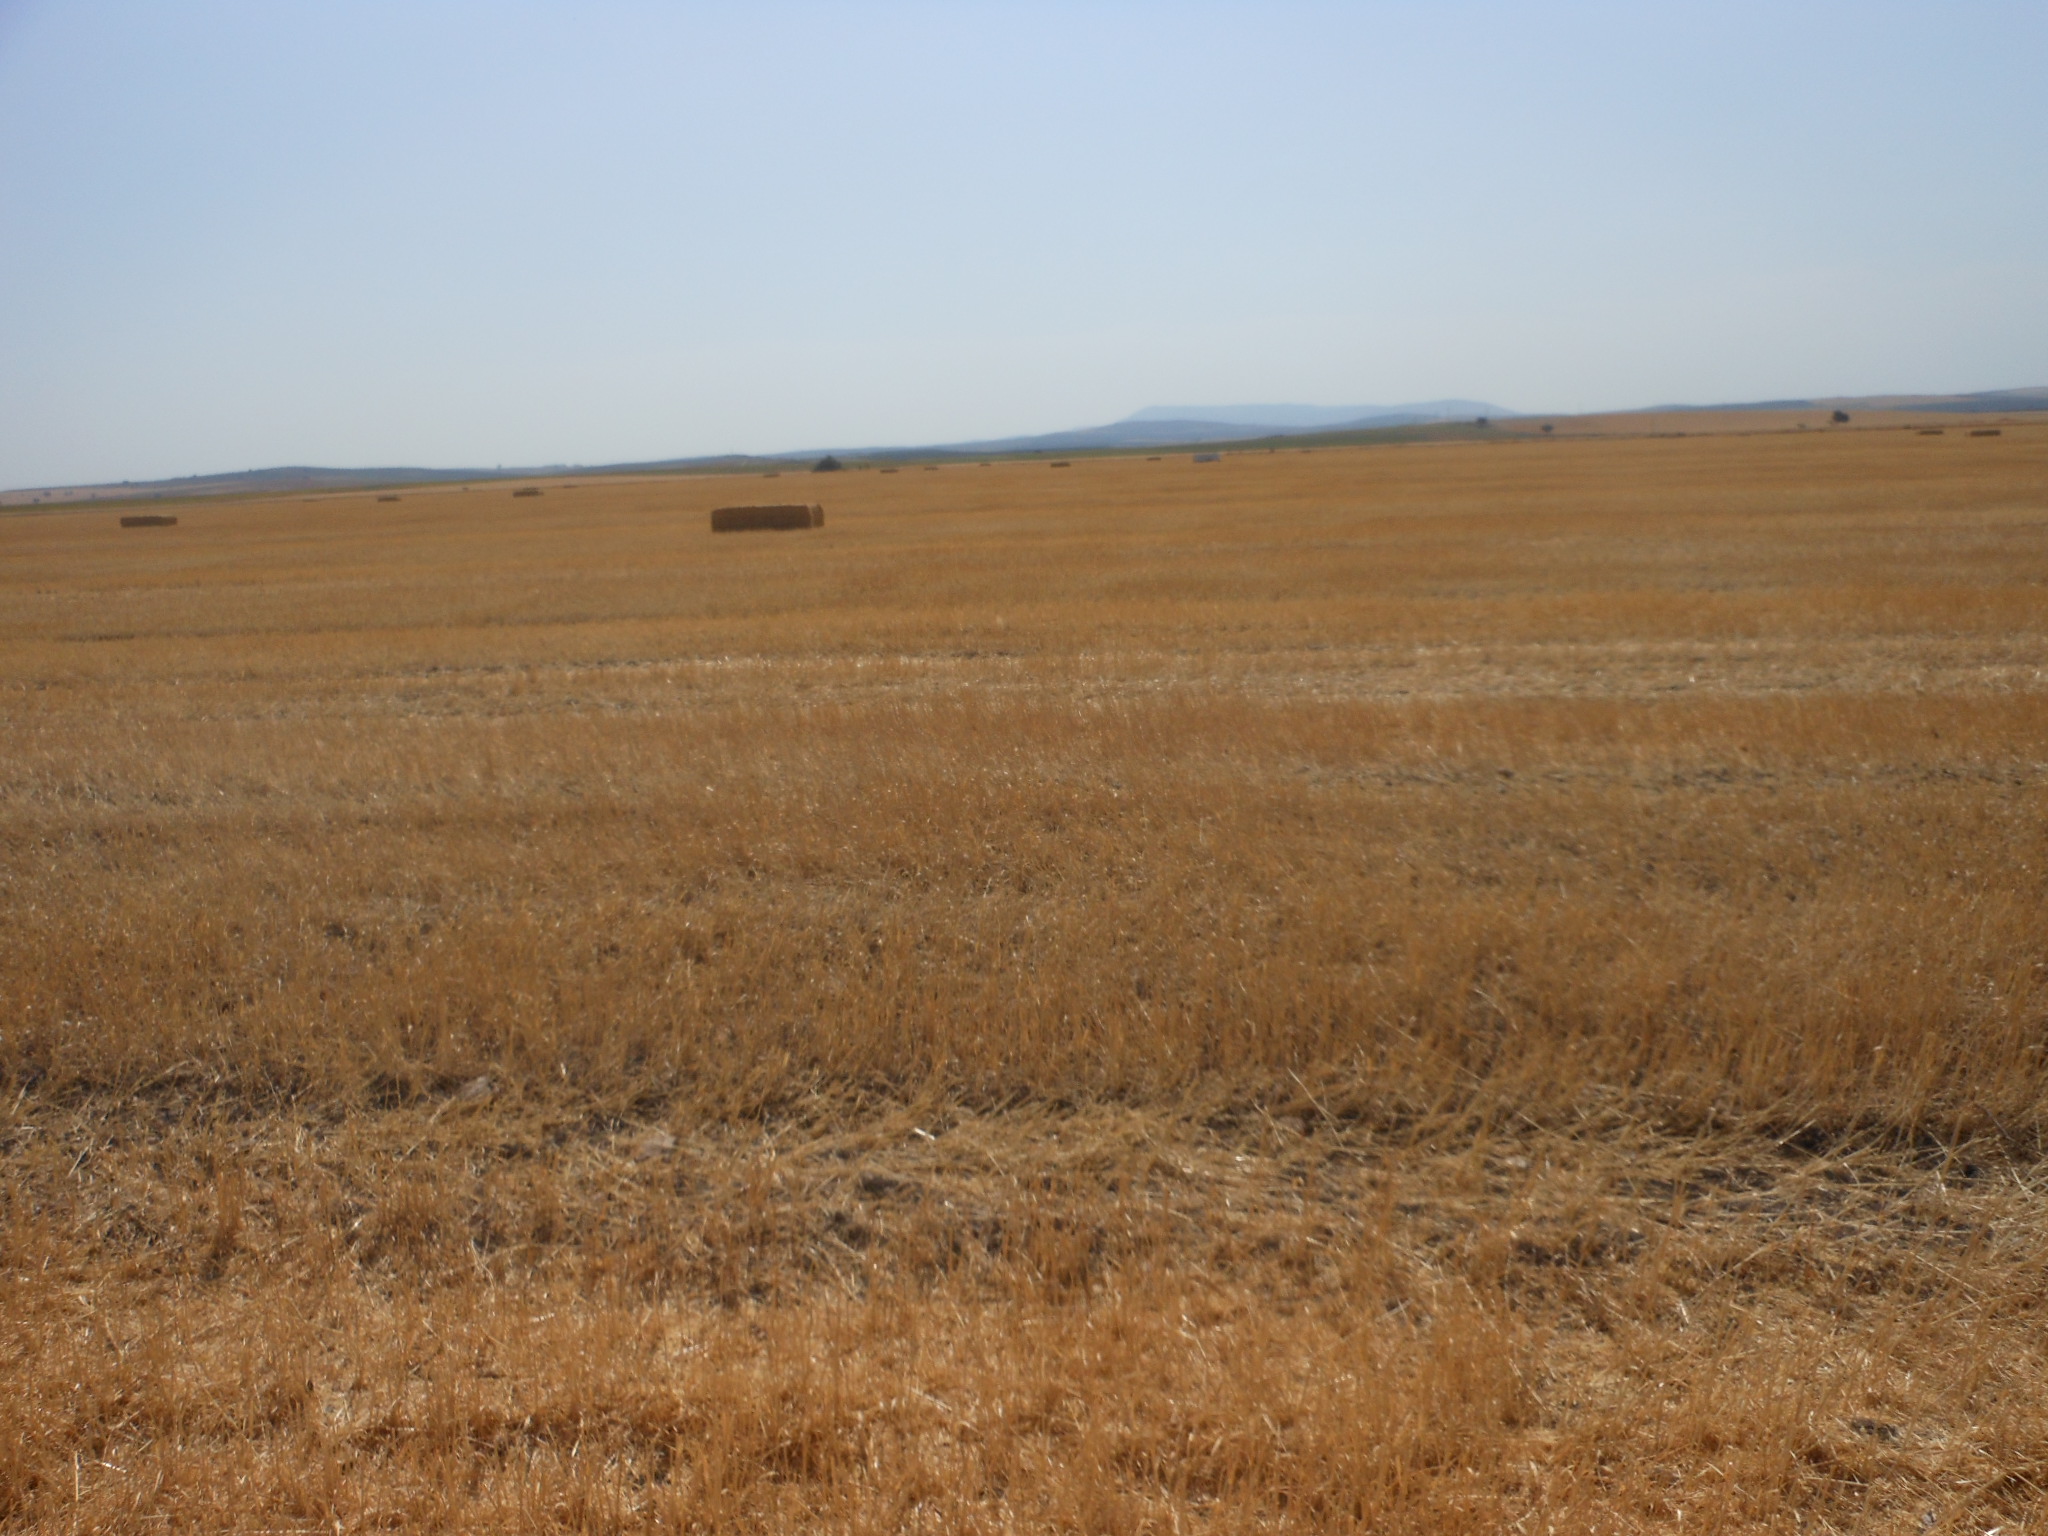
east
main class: Cropland
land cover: Common wheat
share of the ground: < 10 %
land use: Agriculture (excluding fallow land and kitchen gardens)
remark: Harvested field
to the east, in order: Common wheat
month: June
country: ES
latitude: 37.3226
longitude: -5.1197
